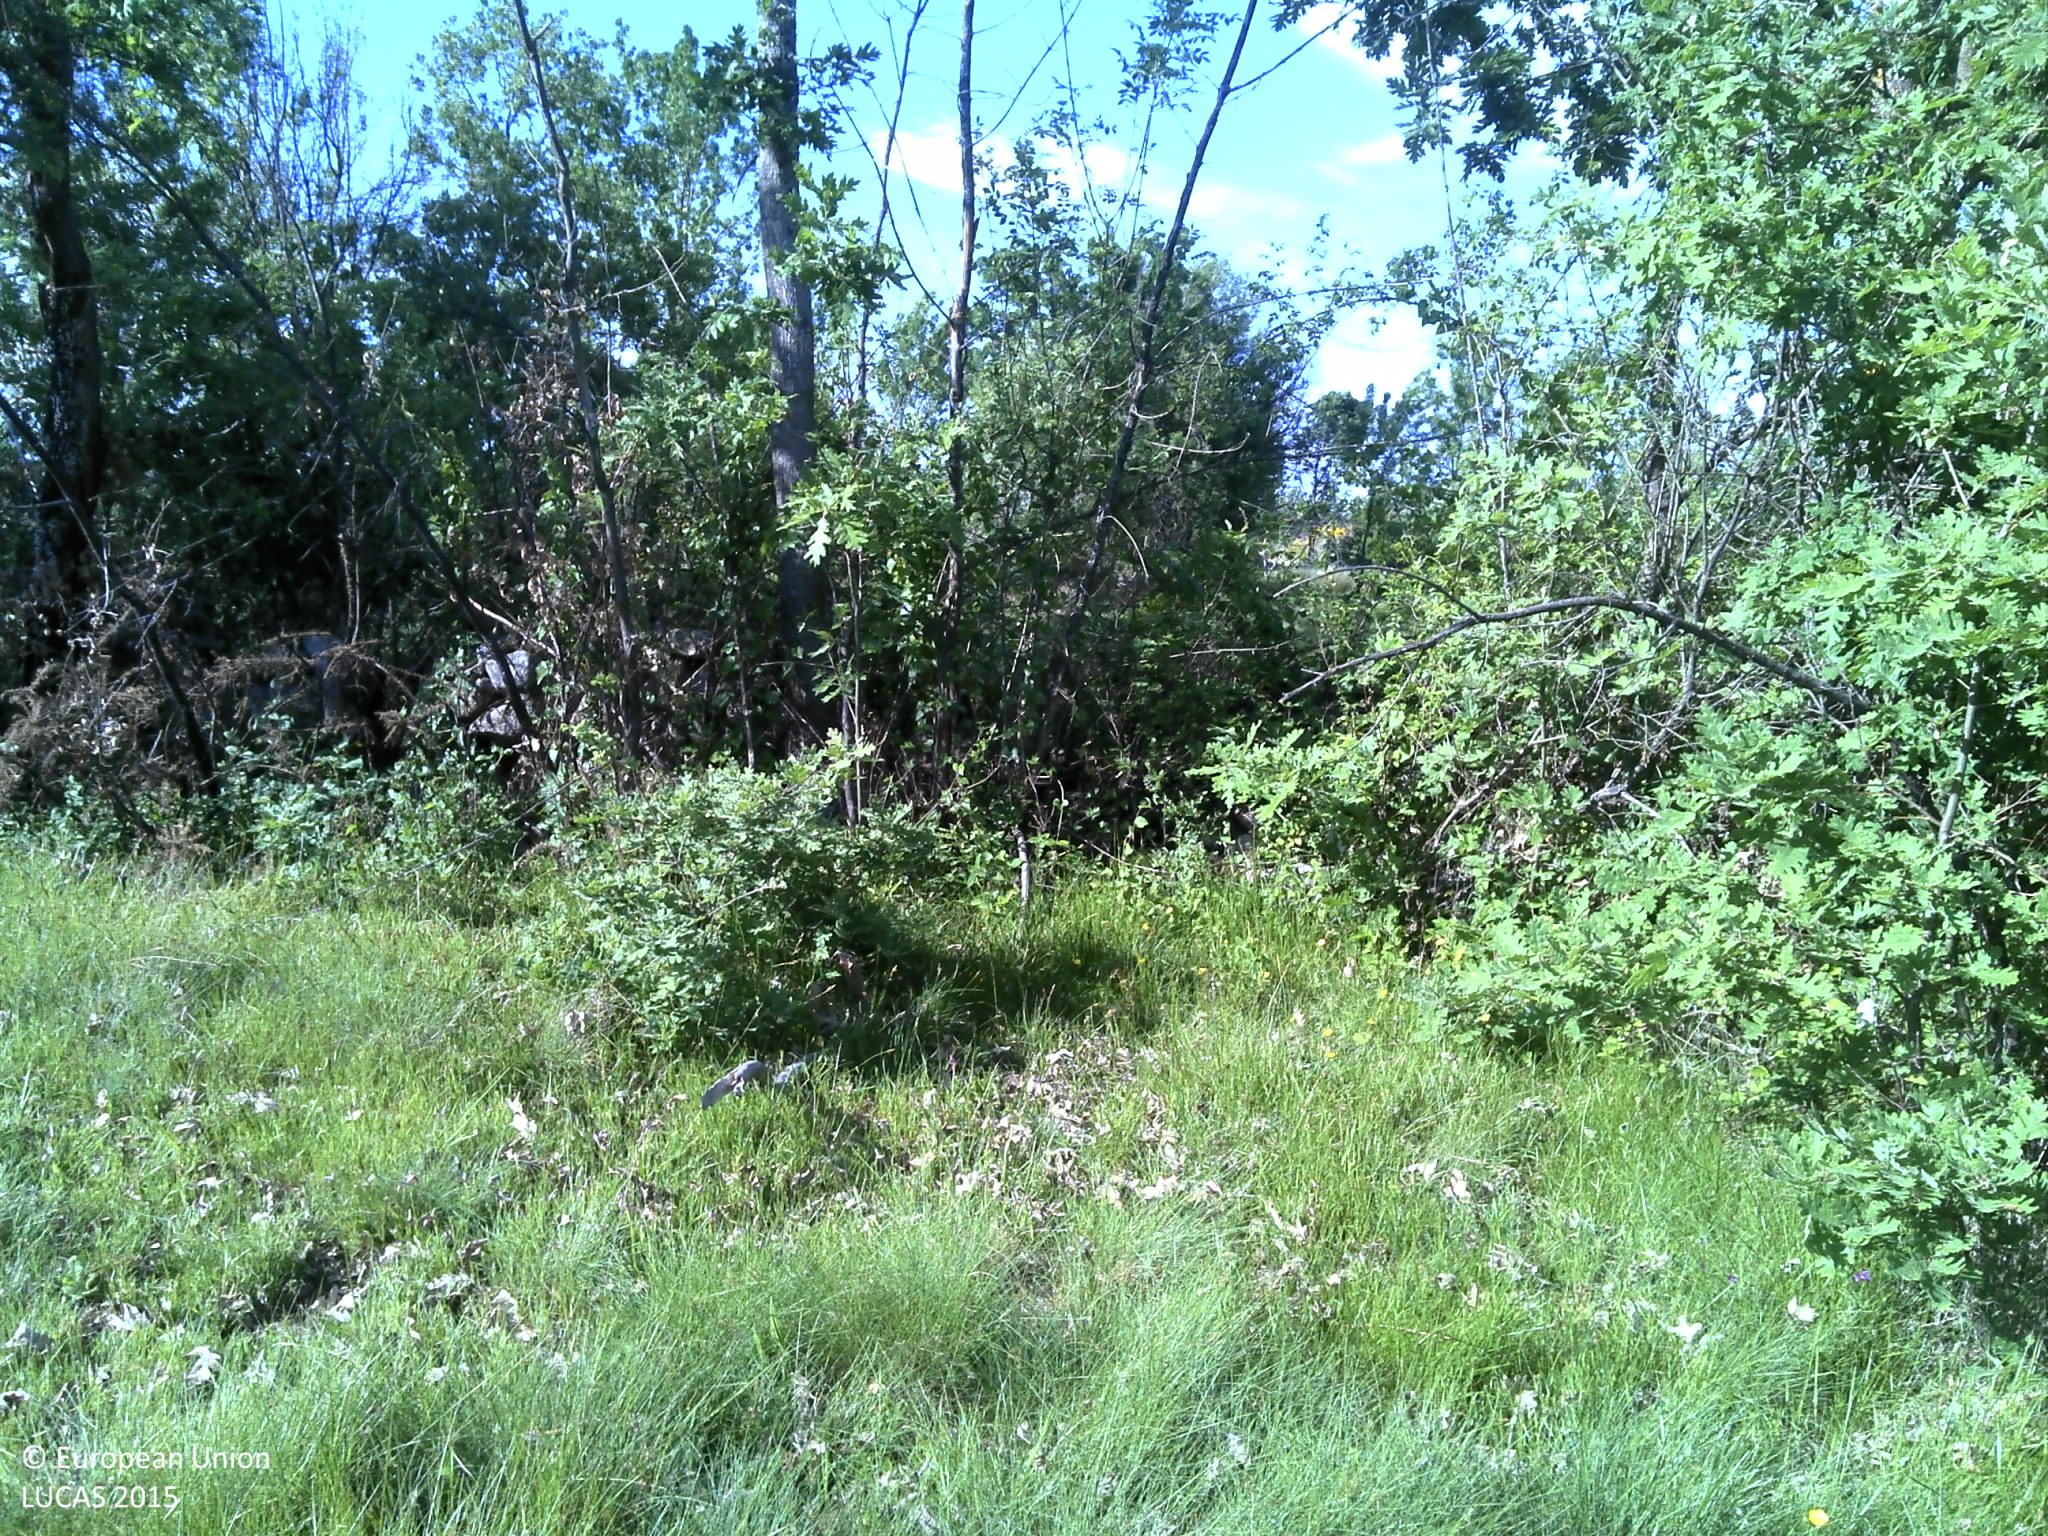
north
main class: Grassland
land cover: Grassland with sparse tree/shrub cover
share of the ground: > 75 %
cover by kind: herbaceous plants 95 %, broadleaved forest trees 5 %
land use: Agriculture (excluding fallow land and kitchen gardens)
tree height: > 5 m
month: May
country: PT
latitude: 41.6794
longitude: -7.3400
